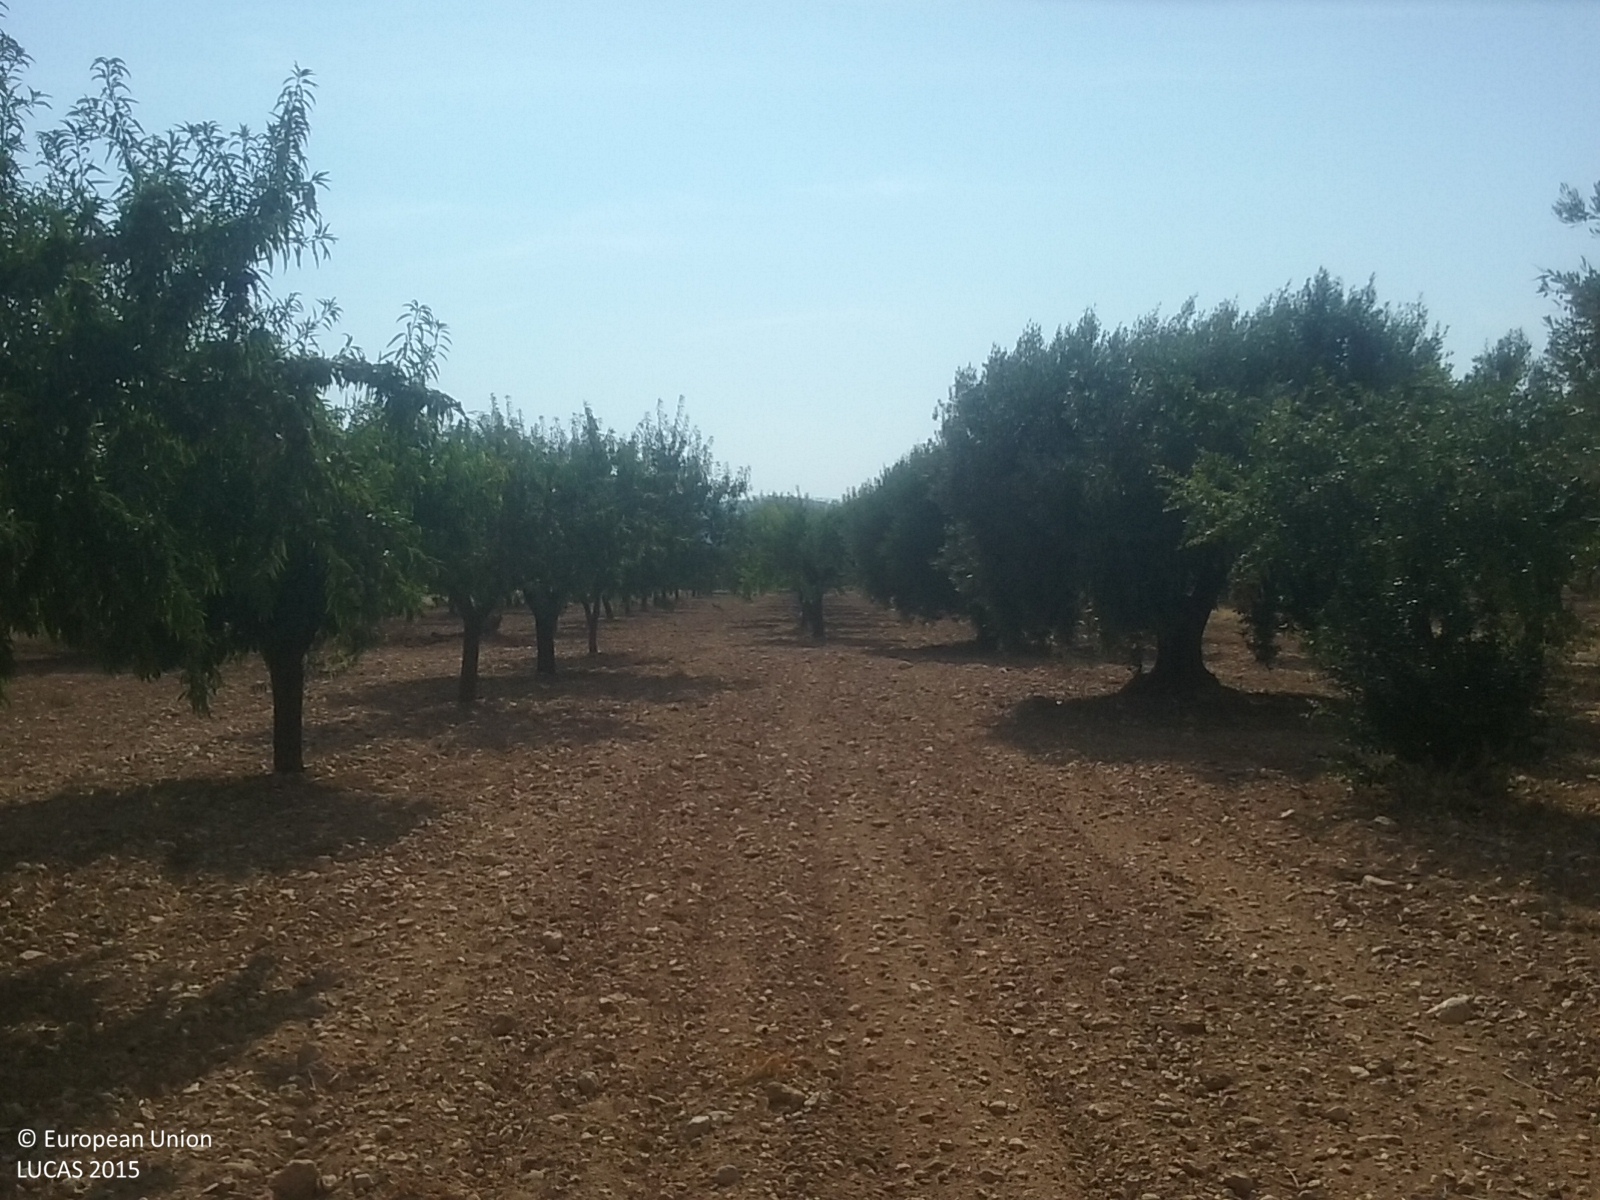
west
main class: Cropland
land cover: Nuts trees
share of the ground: 50 - 75 %
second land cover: Other bare soil
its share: > 75 %
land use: Agriculture (excluding fallow land and kitchen gardens)
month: July
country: ES
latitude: 40.2212
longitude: -0.0743
